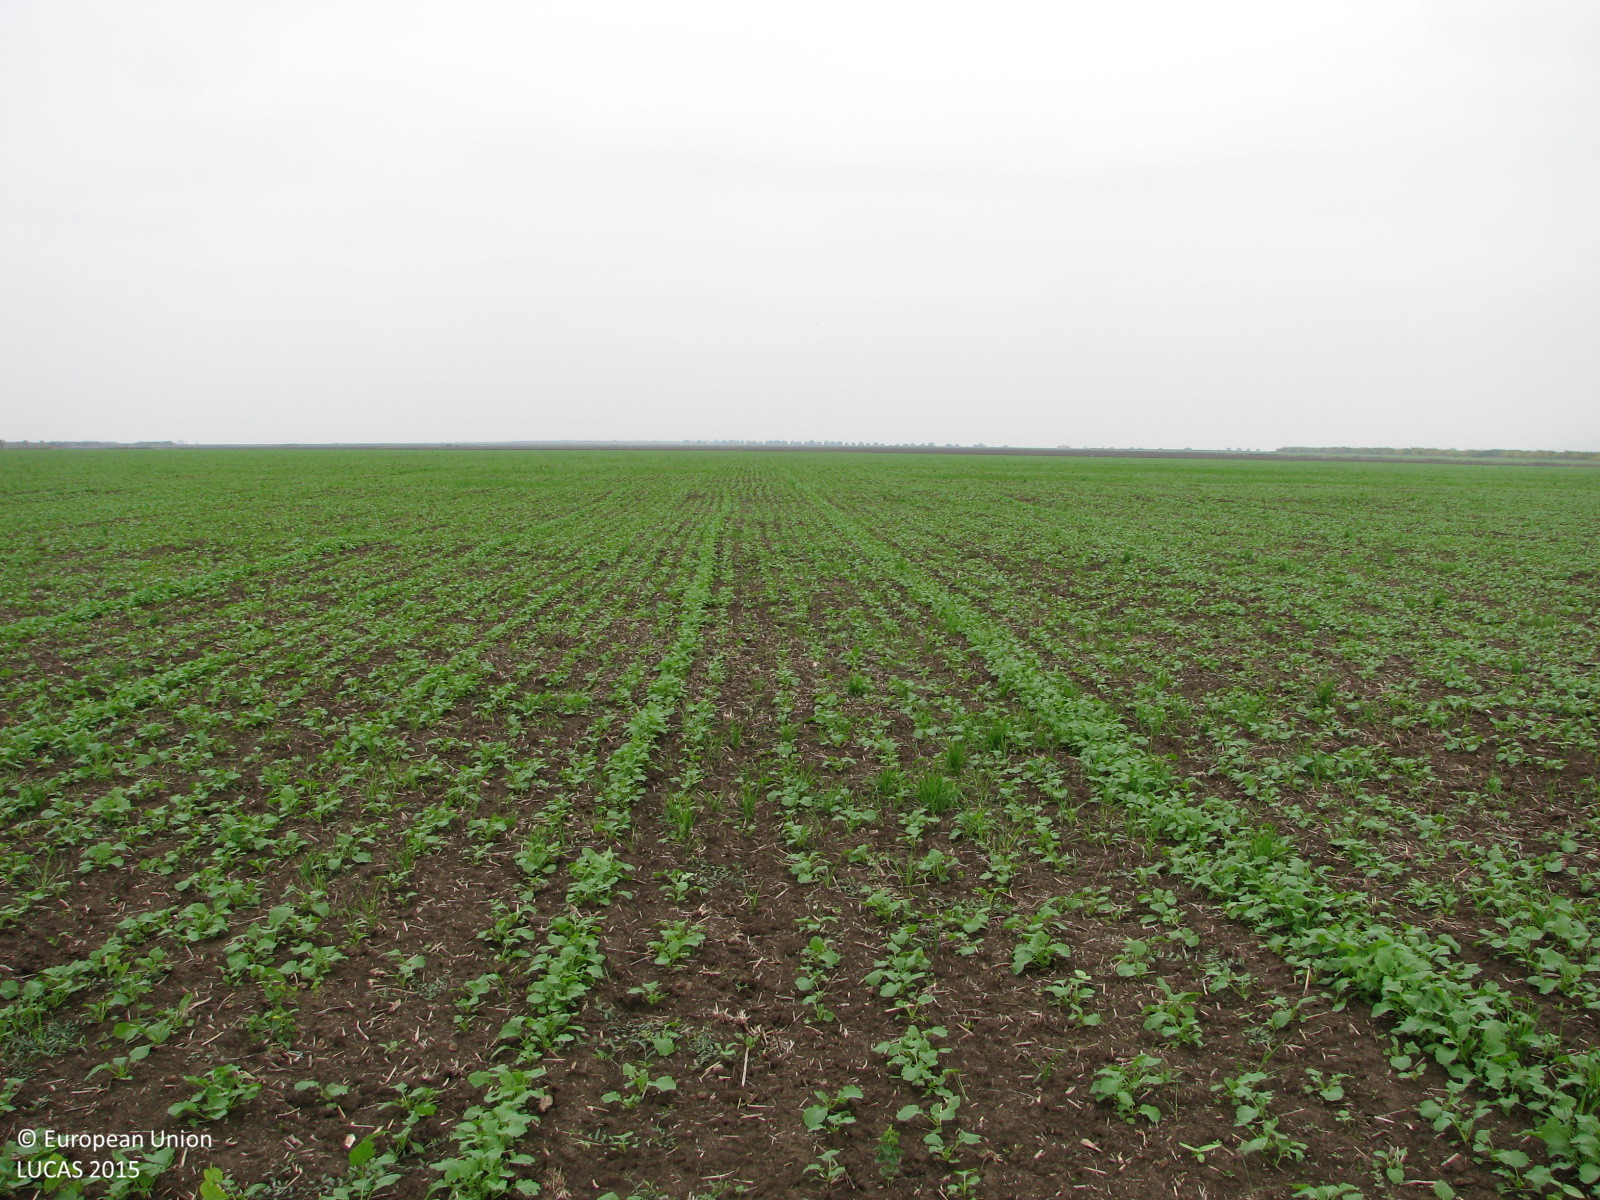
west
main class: Cropland
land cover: Rape and turnip rape
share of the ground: 25 - 50 %
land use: Agriculture (excluding fallow land and kitchen gardens)
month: October
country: BG
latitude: 42.6055
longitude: 26.6625
